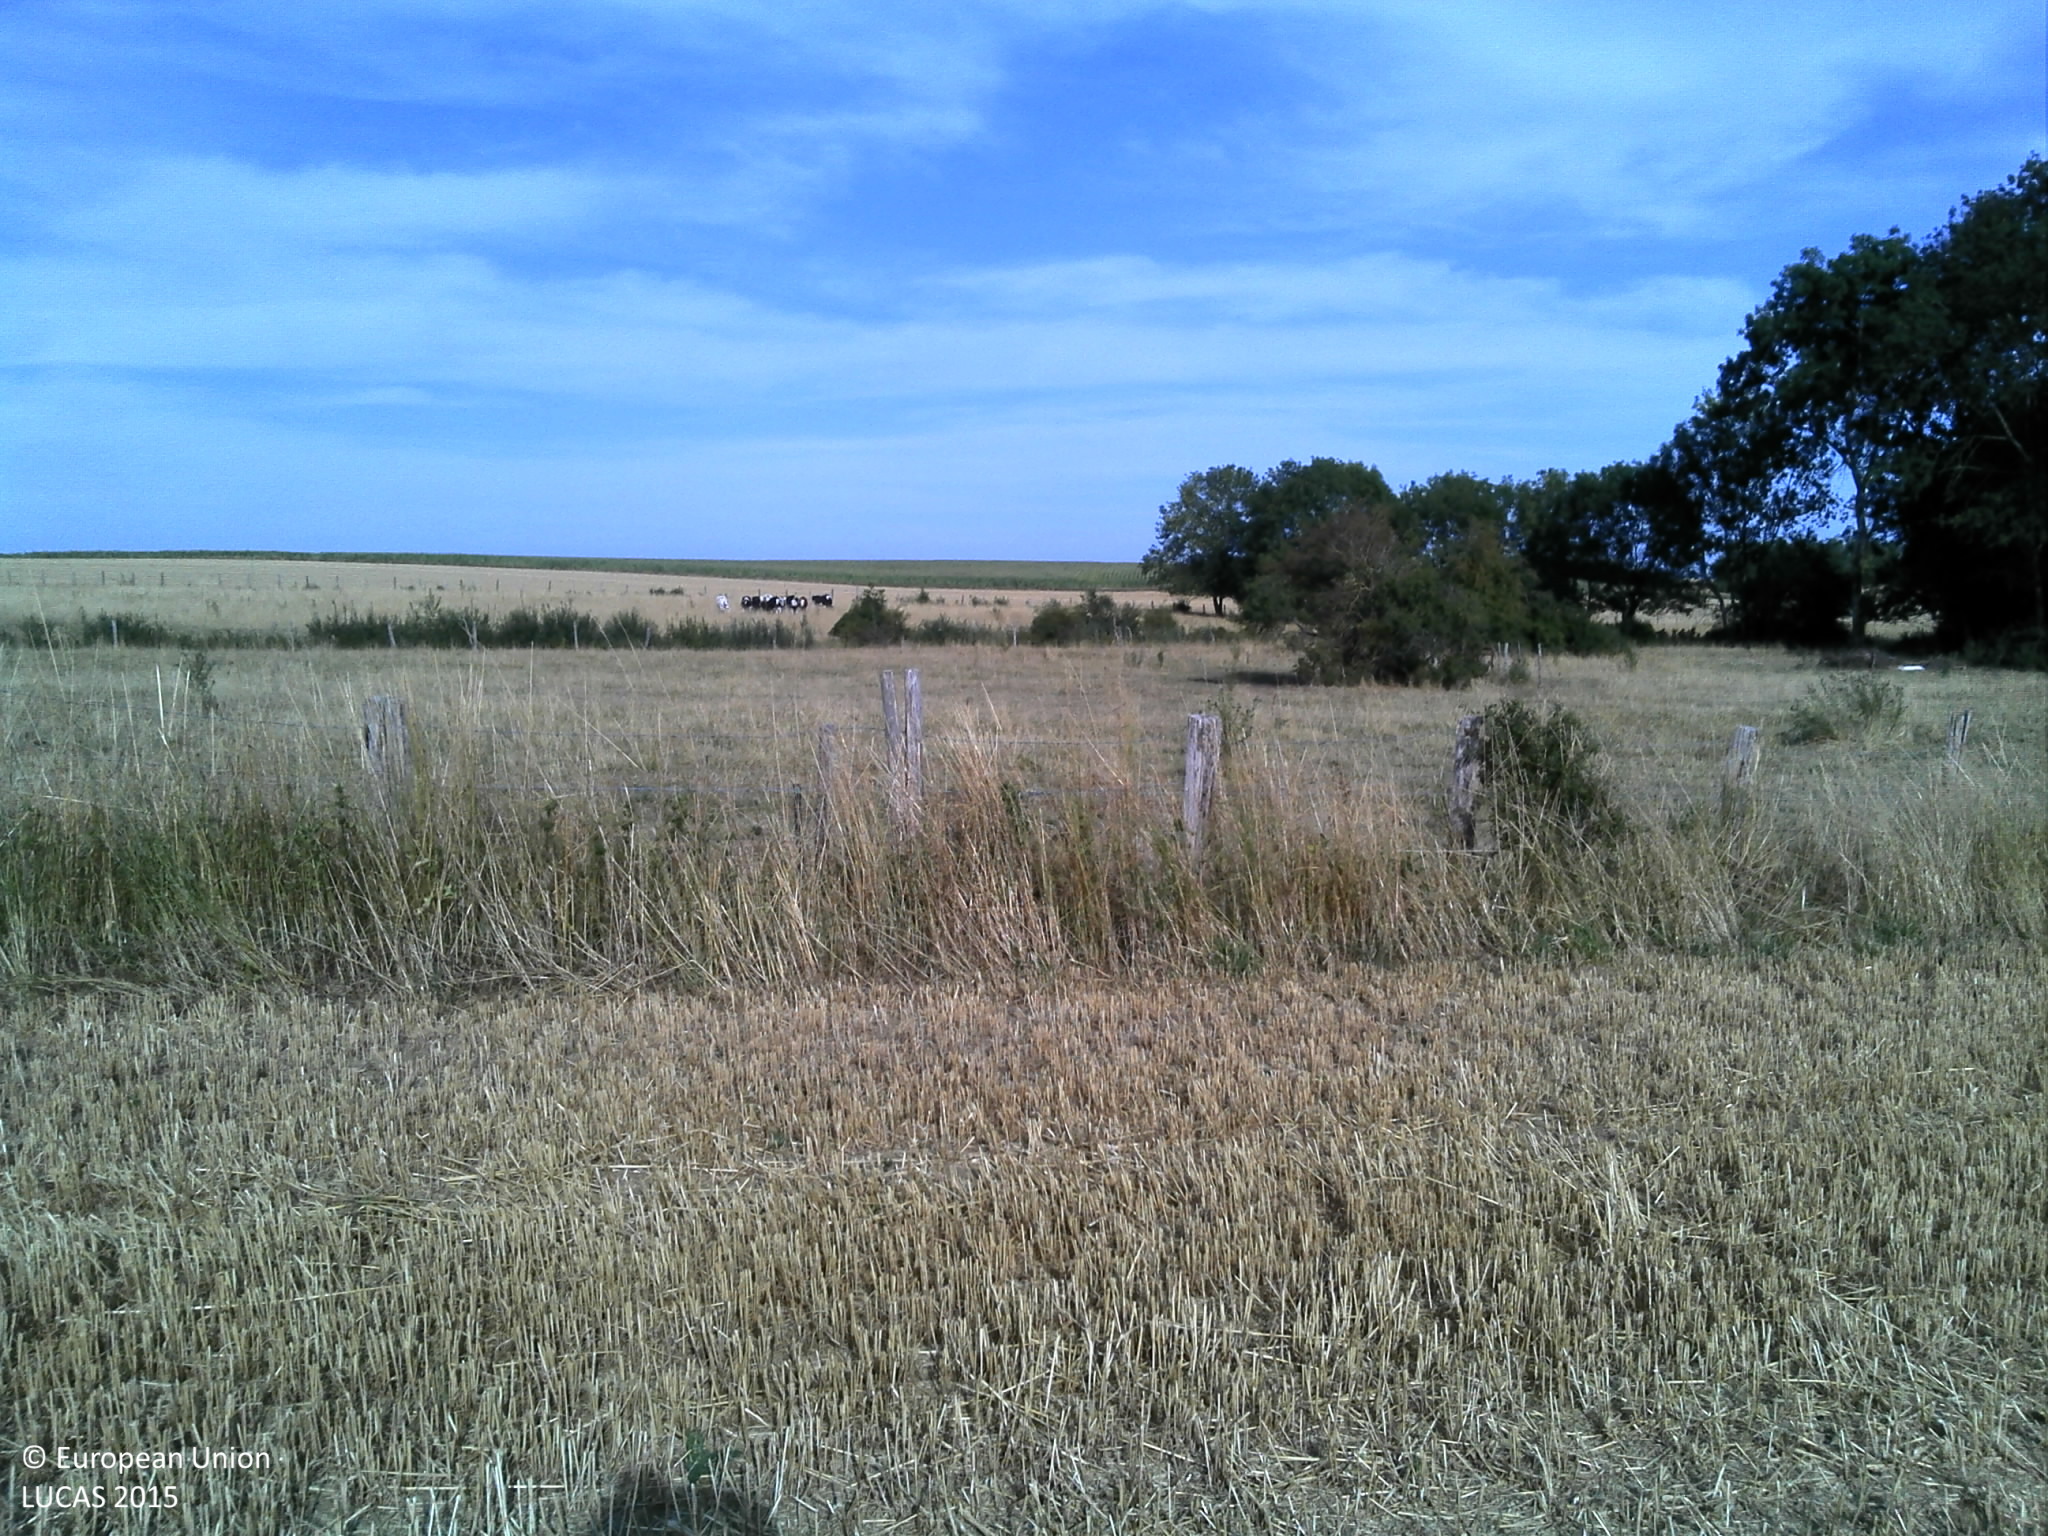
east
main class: Cropland
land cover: Common wheat
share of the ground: > 75 %
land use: Agriculture (excluding fallow land and kitchen gardens)
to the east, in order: Common wheat; Fences; Grassland with sparse tree/shrub cover; Fences; Ditches and canals; Managed hedges; Fences; Grassland without tree/shrub cover; Fences; Common wheat
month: August
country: FR
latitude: 48.9493
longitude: 4.8223
